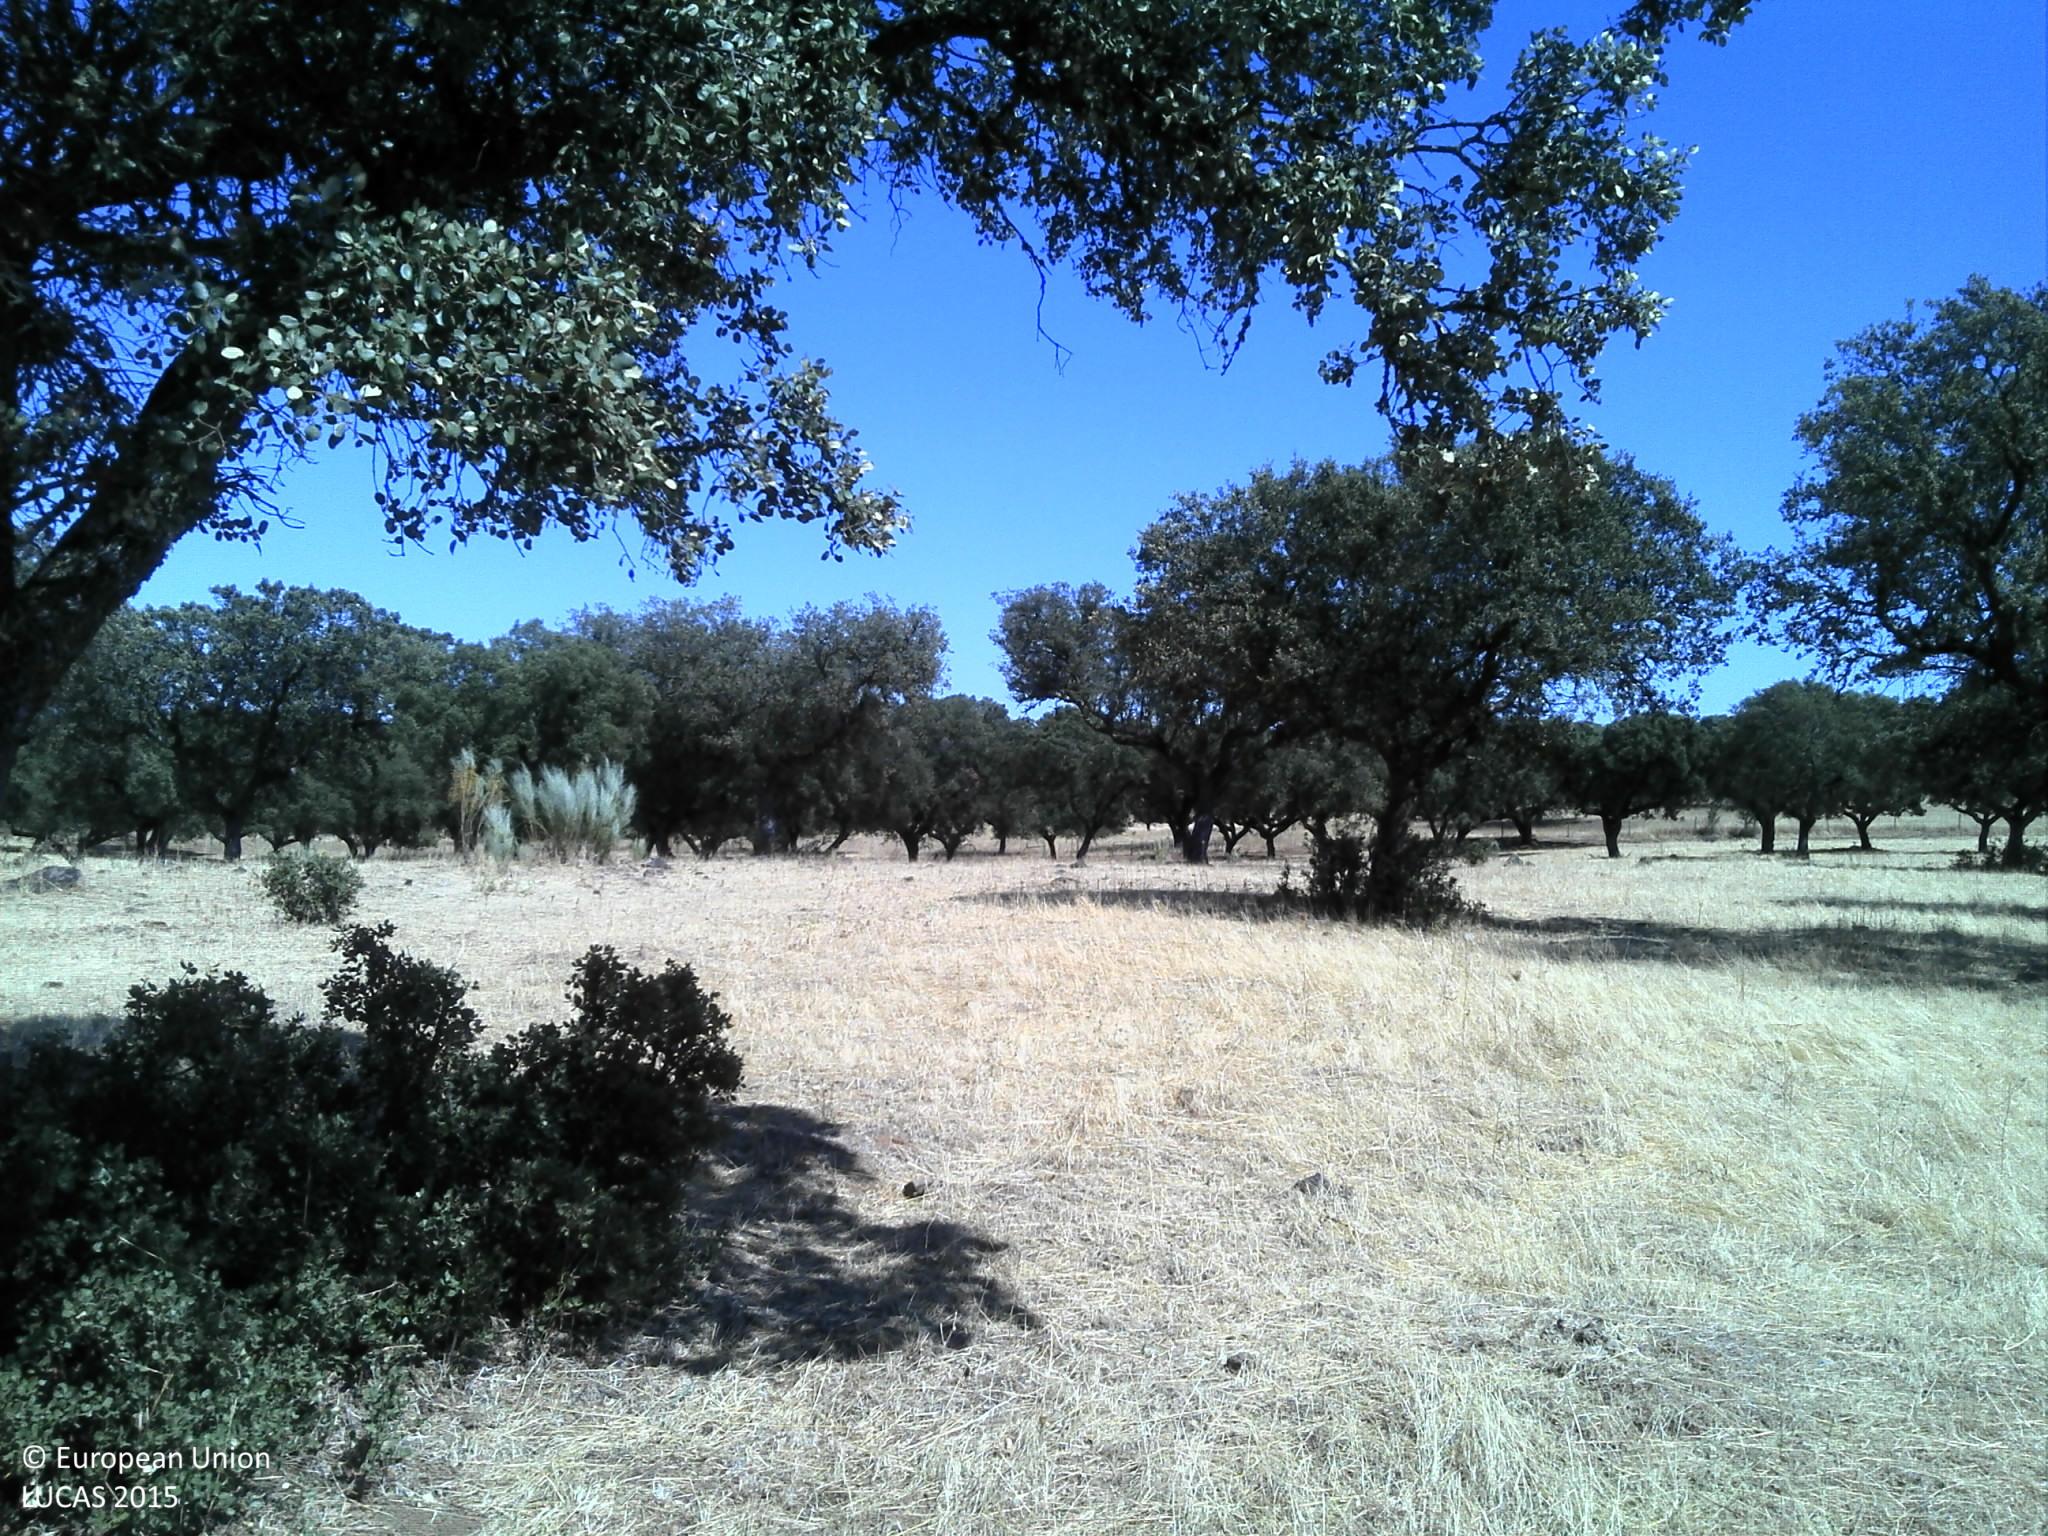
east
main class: Woodland
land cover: Broadleaved woodland
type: broadleaved evergreen forest
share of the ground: 25 - 50 %
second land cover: Grassland without tree/shrub cover
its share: 10 - 25 %
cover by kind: unconsolidated bare surface 55 %, broadleaved forest trees 25 %, herbaceous plants 20 %
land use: Forestry
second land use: Agriculture (excluding fallow land and kitchen gardens)
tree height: > 5 m
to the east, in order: Broadleaved woodland; Grassland without tree/shrub cover; Broadleaved woodland; Fences; Single bushes/trees; Other structural elements; Grassland without tree/shrub cover
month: July
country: PT
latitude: 39.0243
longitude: -7.5384
